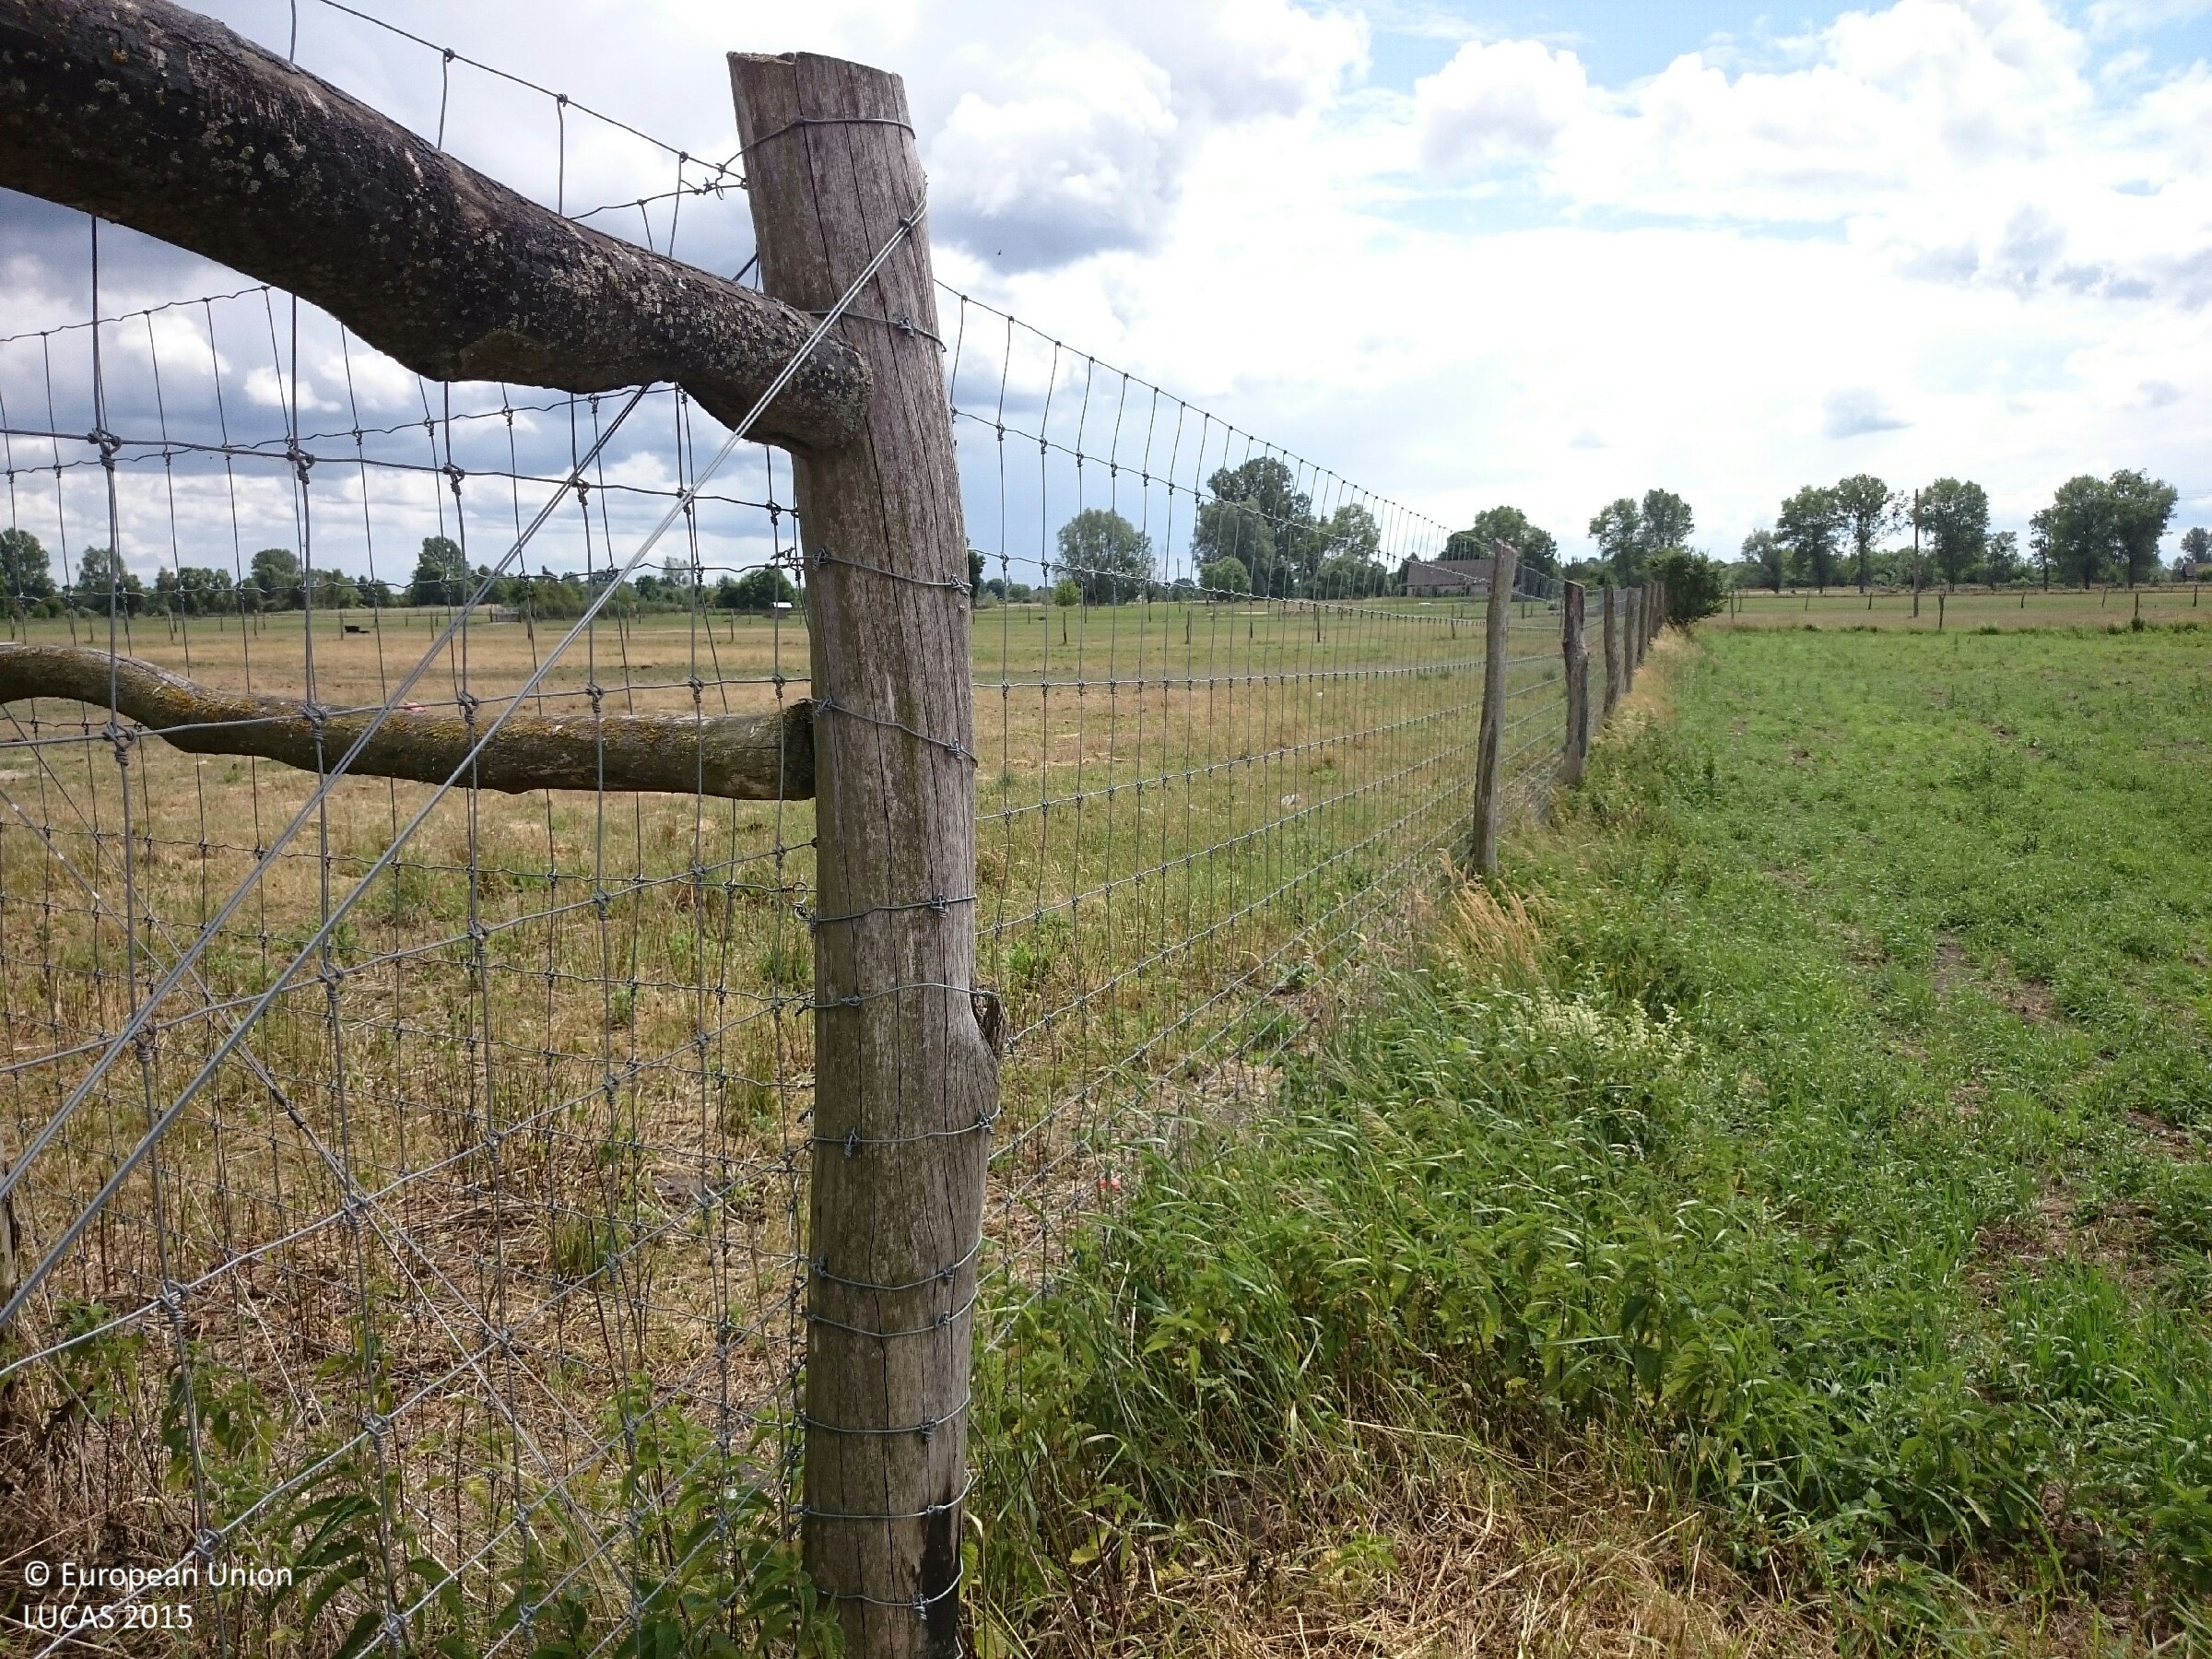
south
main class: Grassland
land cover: Grassland without tree/shrub cover
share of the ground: > 75 %
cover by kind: herbaceous plants 100 %
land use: Agriculture (excluding fallow land and kitchen gardens)
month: June
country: PL
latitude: 52.8192
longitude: 15.6578
